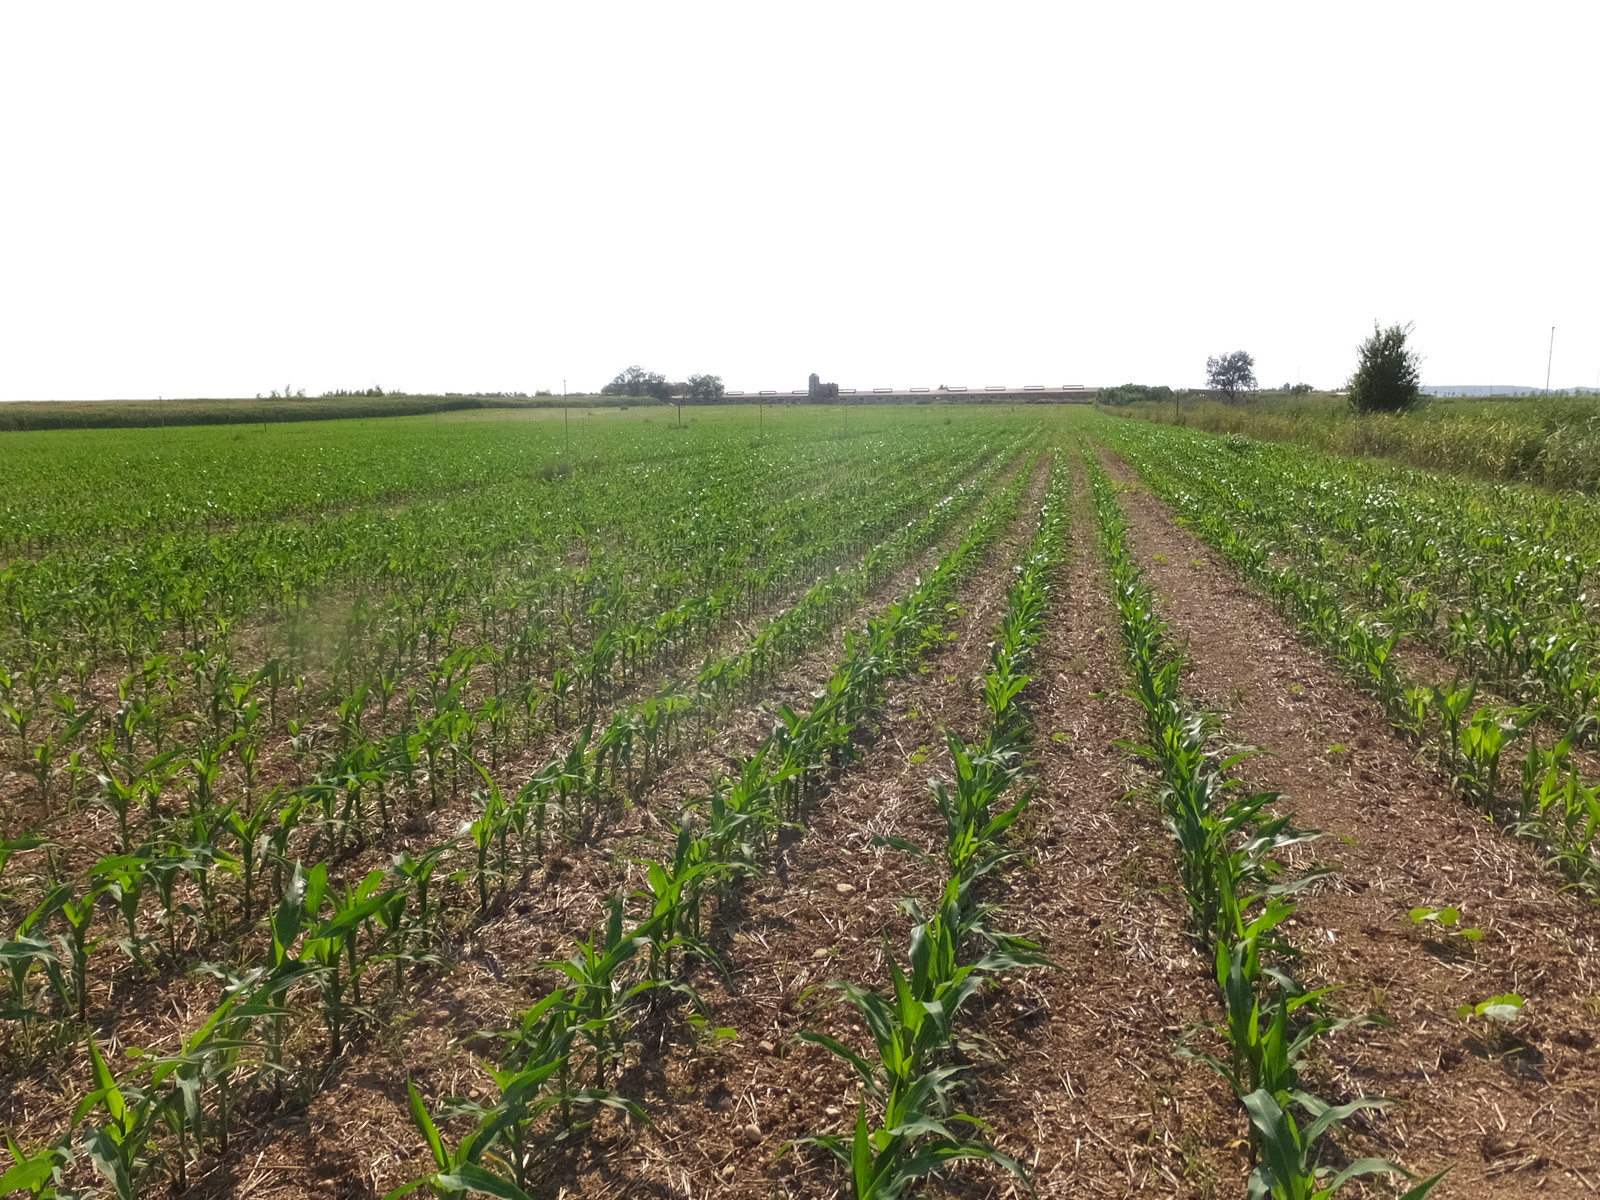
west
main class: Cropland
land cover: Maize
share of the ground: 10 - 25 %
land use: Agriculture (excluding fallow land and kitchen gardens)
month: July
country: ES
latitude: 41.7157
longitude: 0.3097
